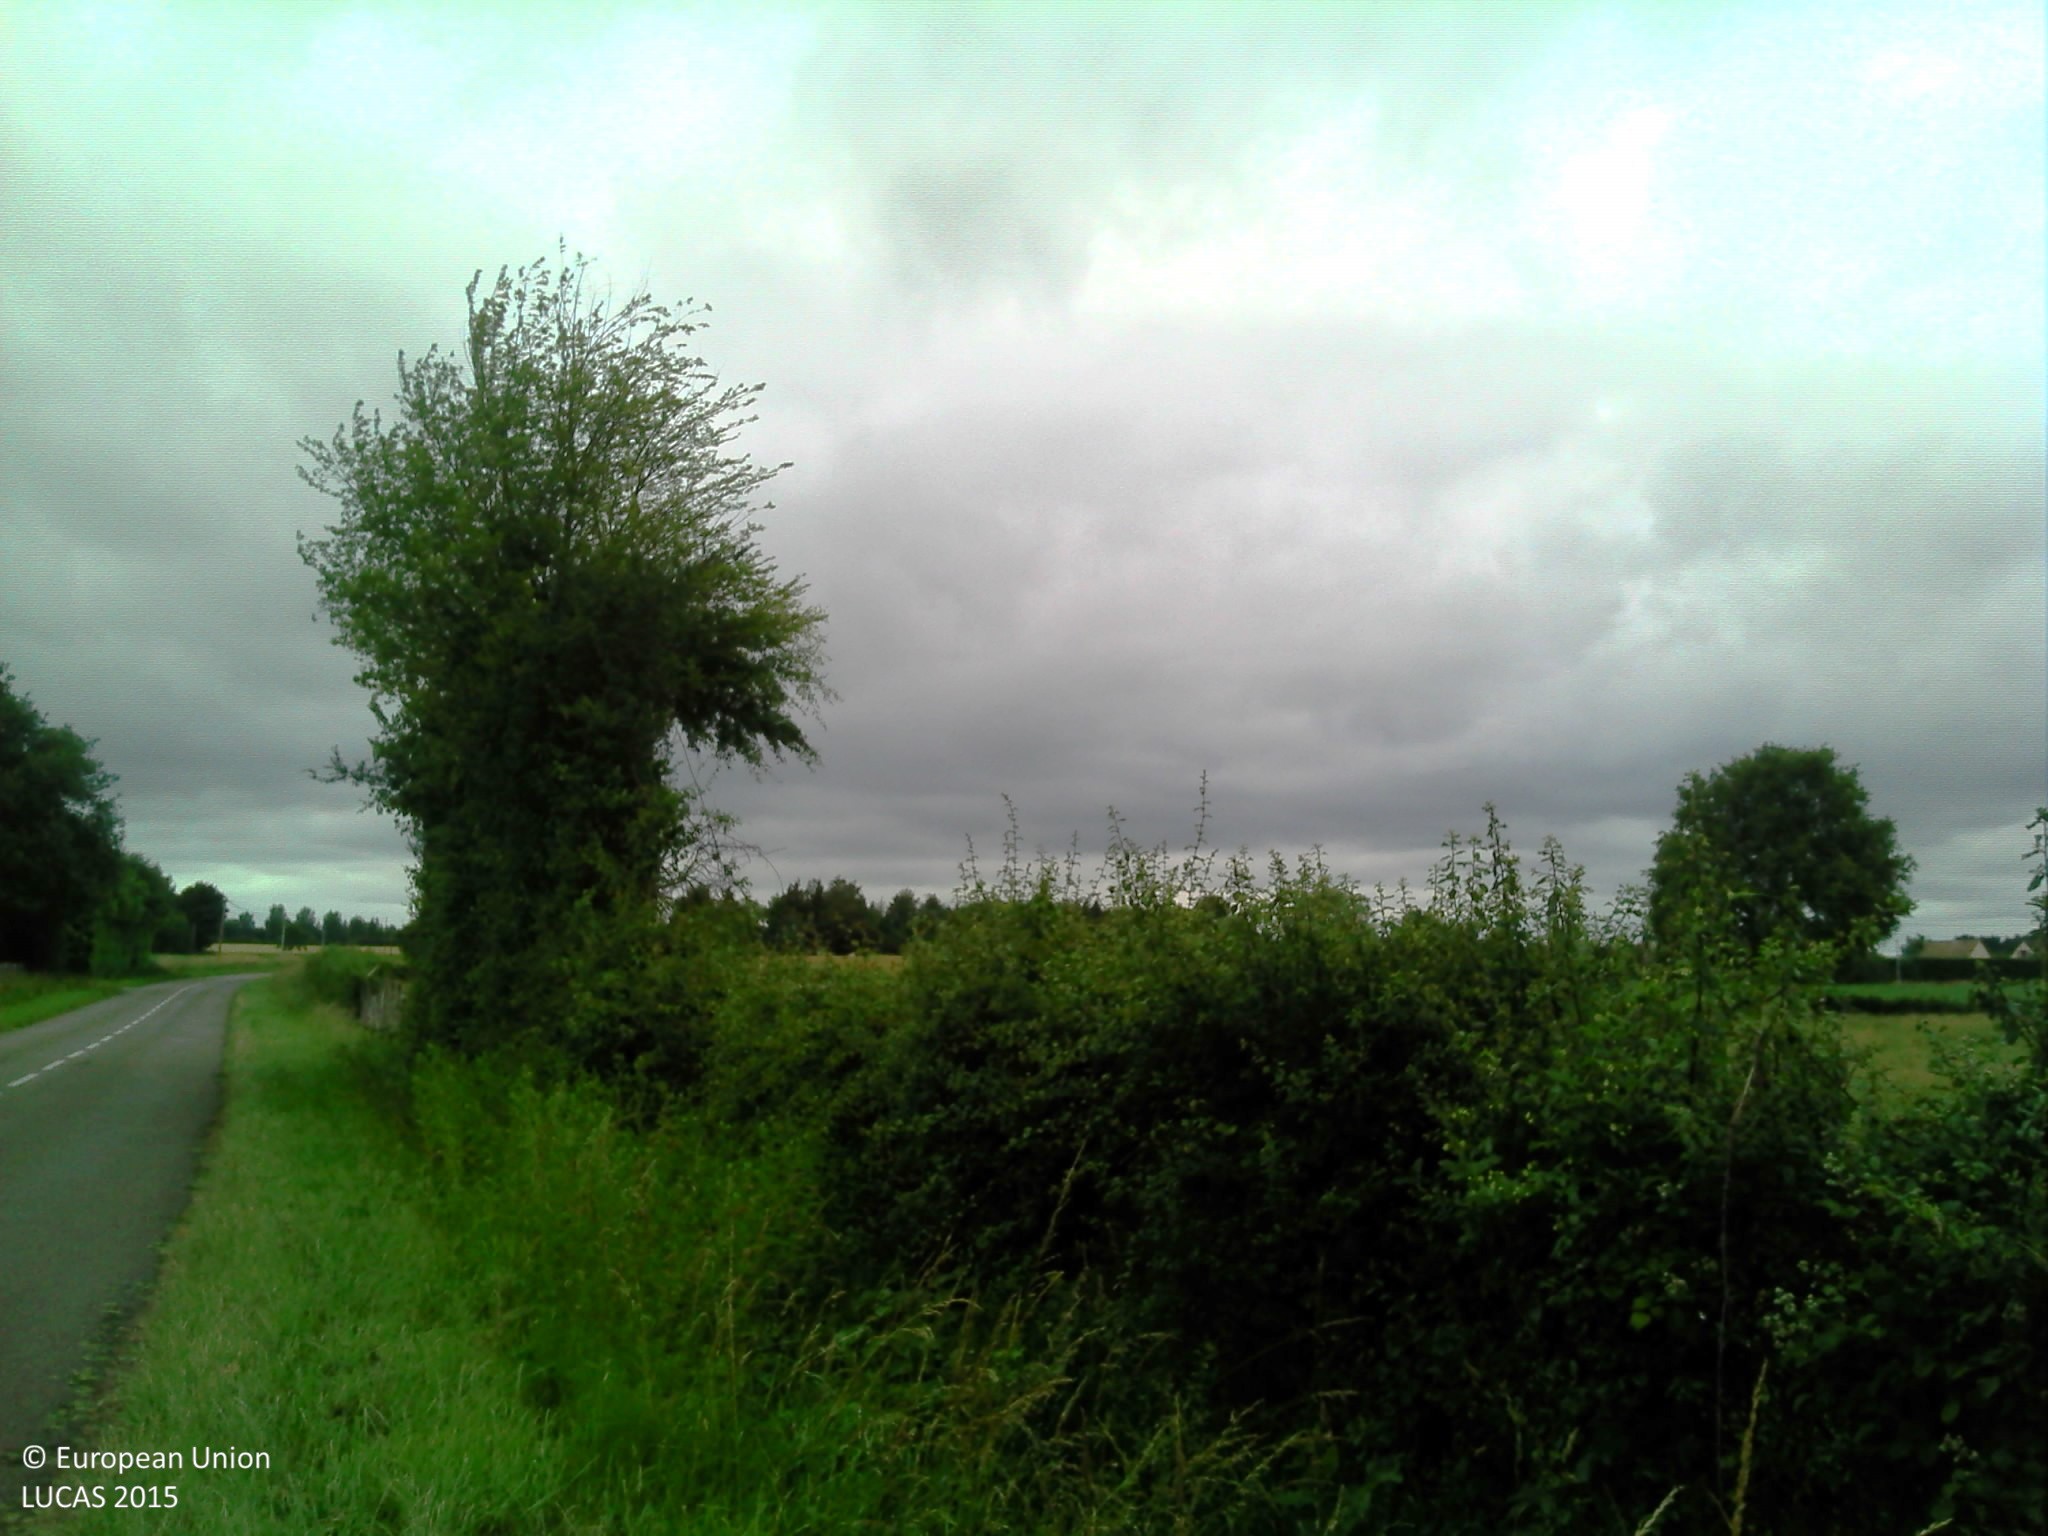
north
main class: Grassland
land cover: Grassland without tree/shrub cover
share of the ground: > 75 %
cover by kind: herbaceous plants 100 %
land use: Agriculture (excluding fallow land and kitchen gardens)
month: June
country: FR
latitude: 48.0844
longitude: 0.2955
